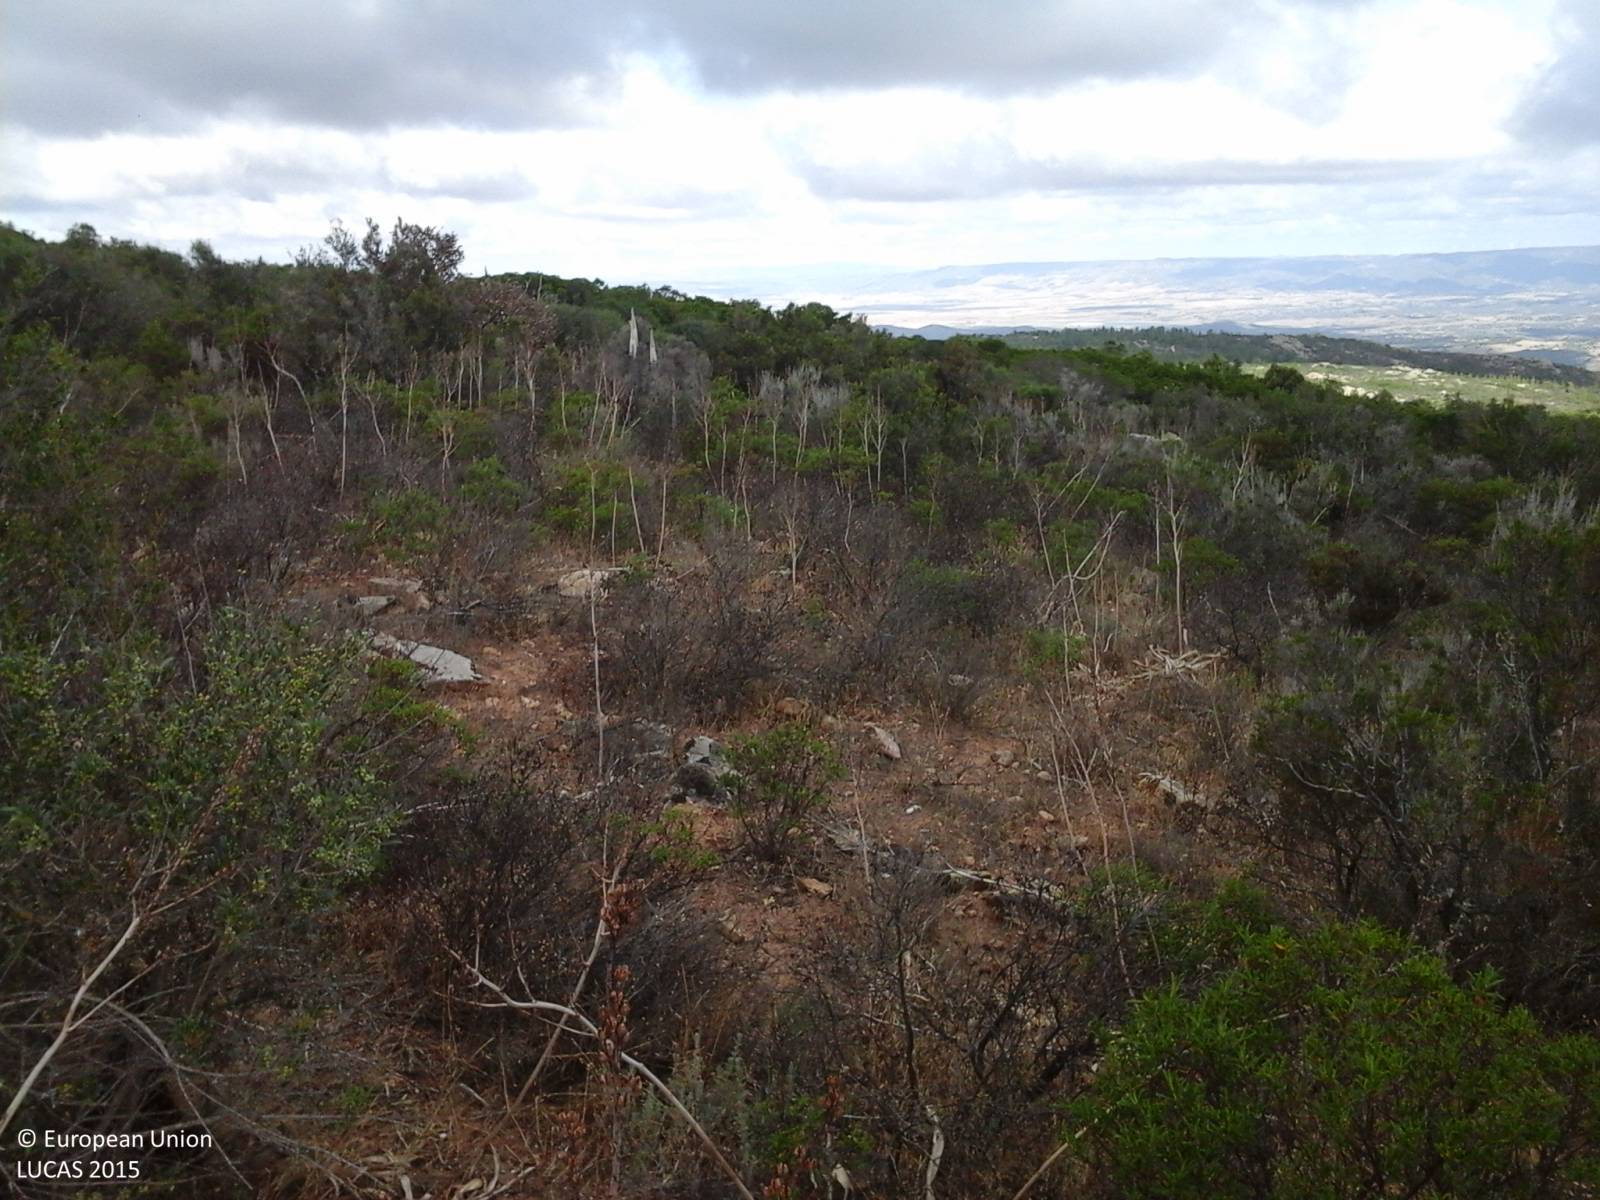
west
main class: Shrubland
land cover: Shrubland without tree cover
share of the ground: > 75 %
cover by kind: shrubs 70 %, herbaceous plants 30 %
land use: Semi-natural and natural areas not in use
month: August
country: IT
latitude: 40.6620
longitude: 9.1643
